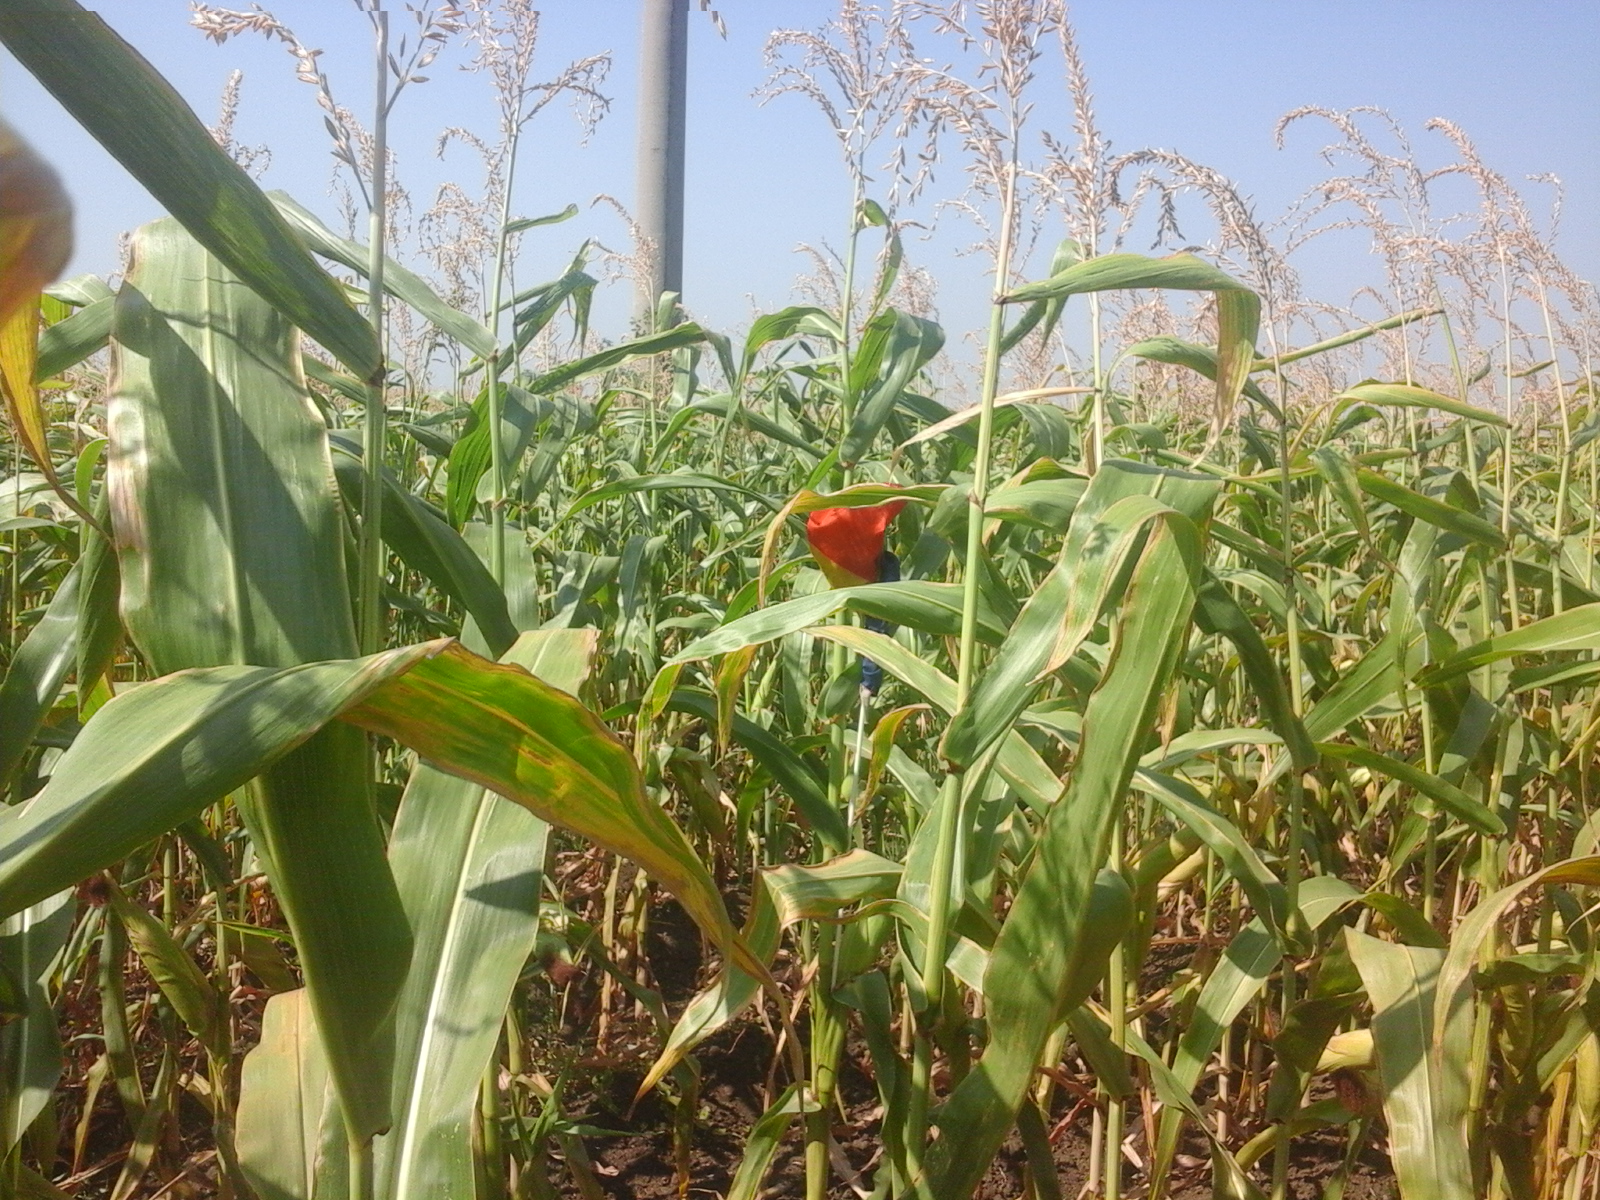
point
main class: Cropland
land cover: Maize
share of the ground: > 75 %
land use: Agriculture (excluding fallow land and kitchen gardens)
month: August
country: RO
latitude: 45.8081
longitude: 27.6486
